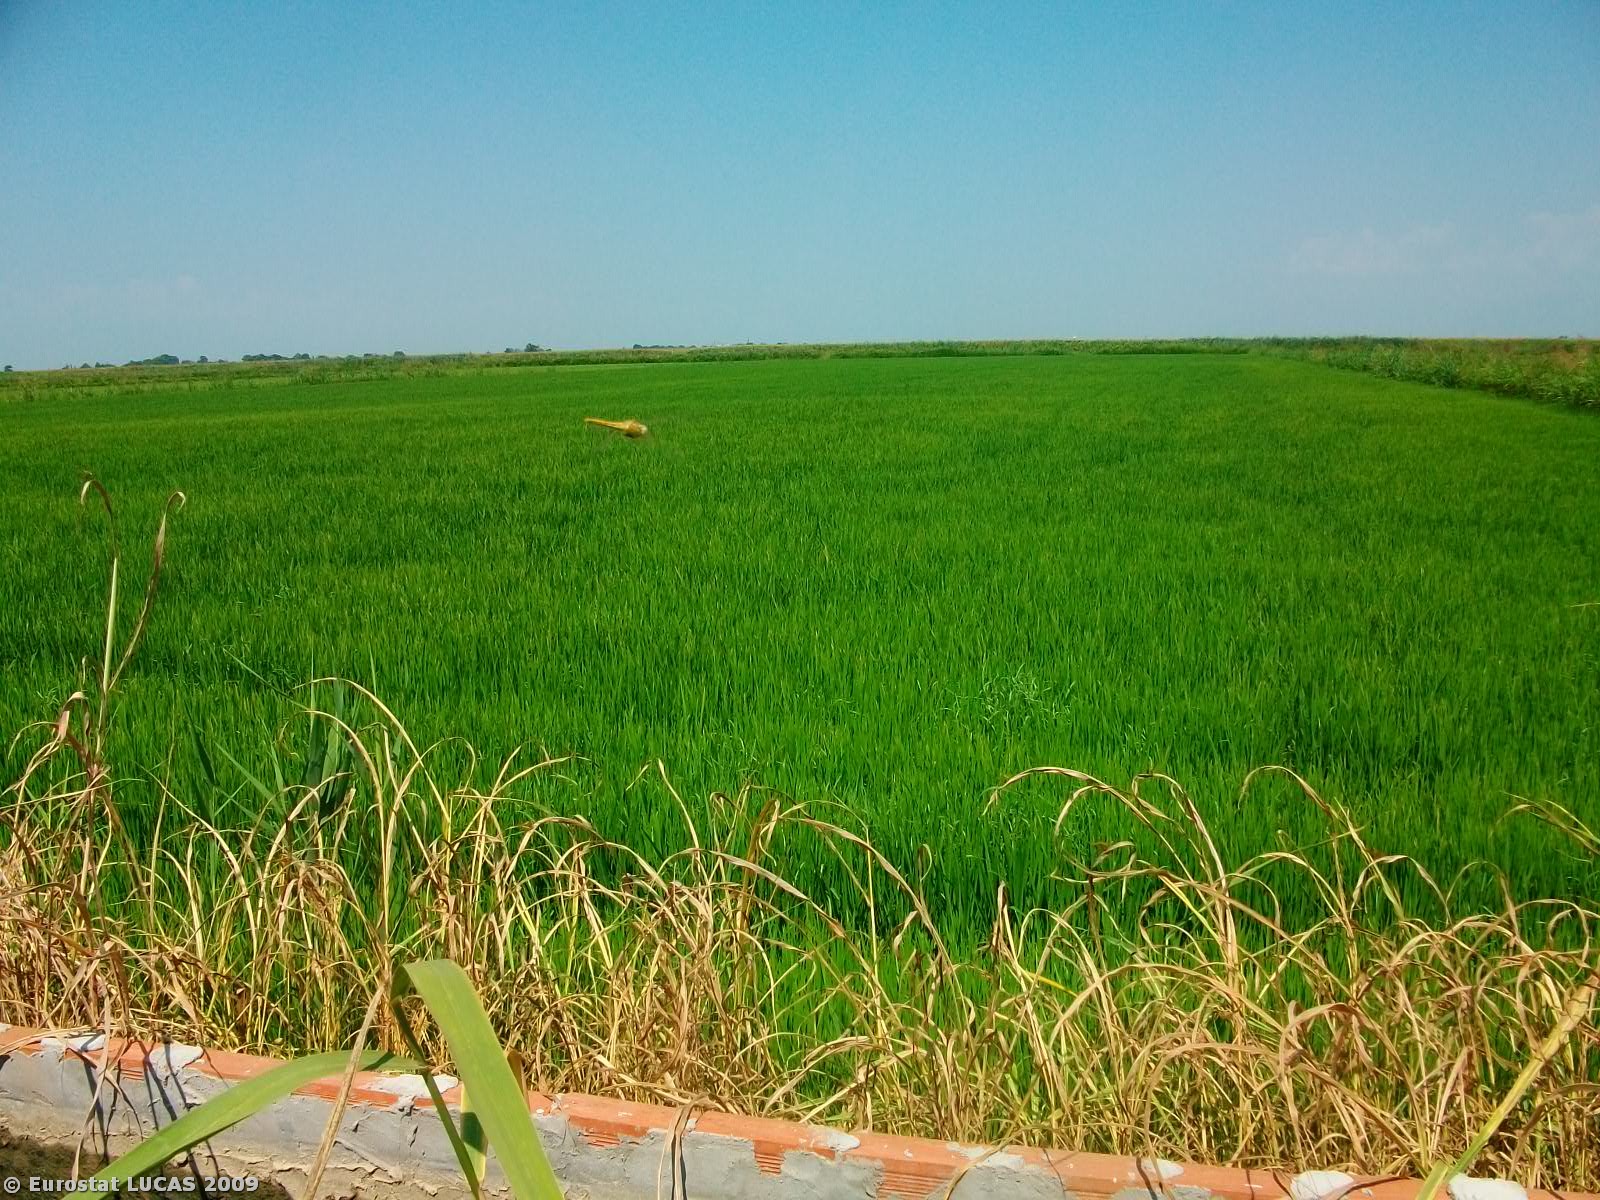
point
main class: Cropland
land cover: Rice
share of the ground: > 75 %
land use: Agriculture (excluding fallow land and kitchen gardens)
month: July
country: GR
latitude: 40.6492
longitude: 22.6699
